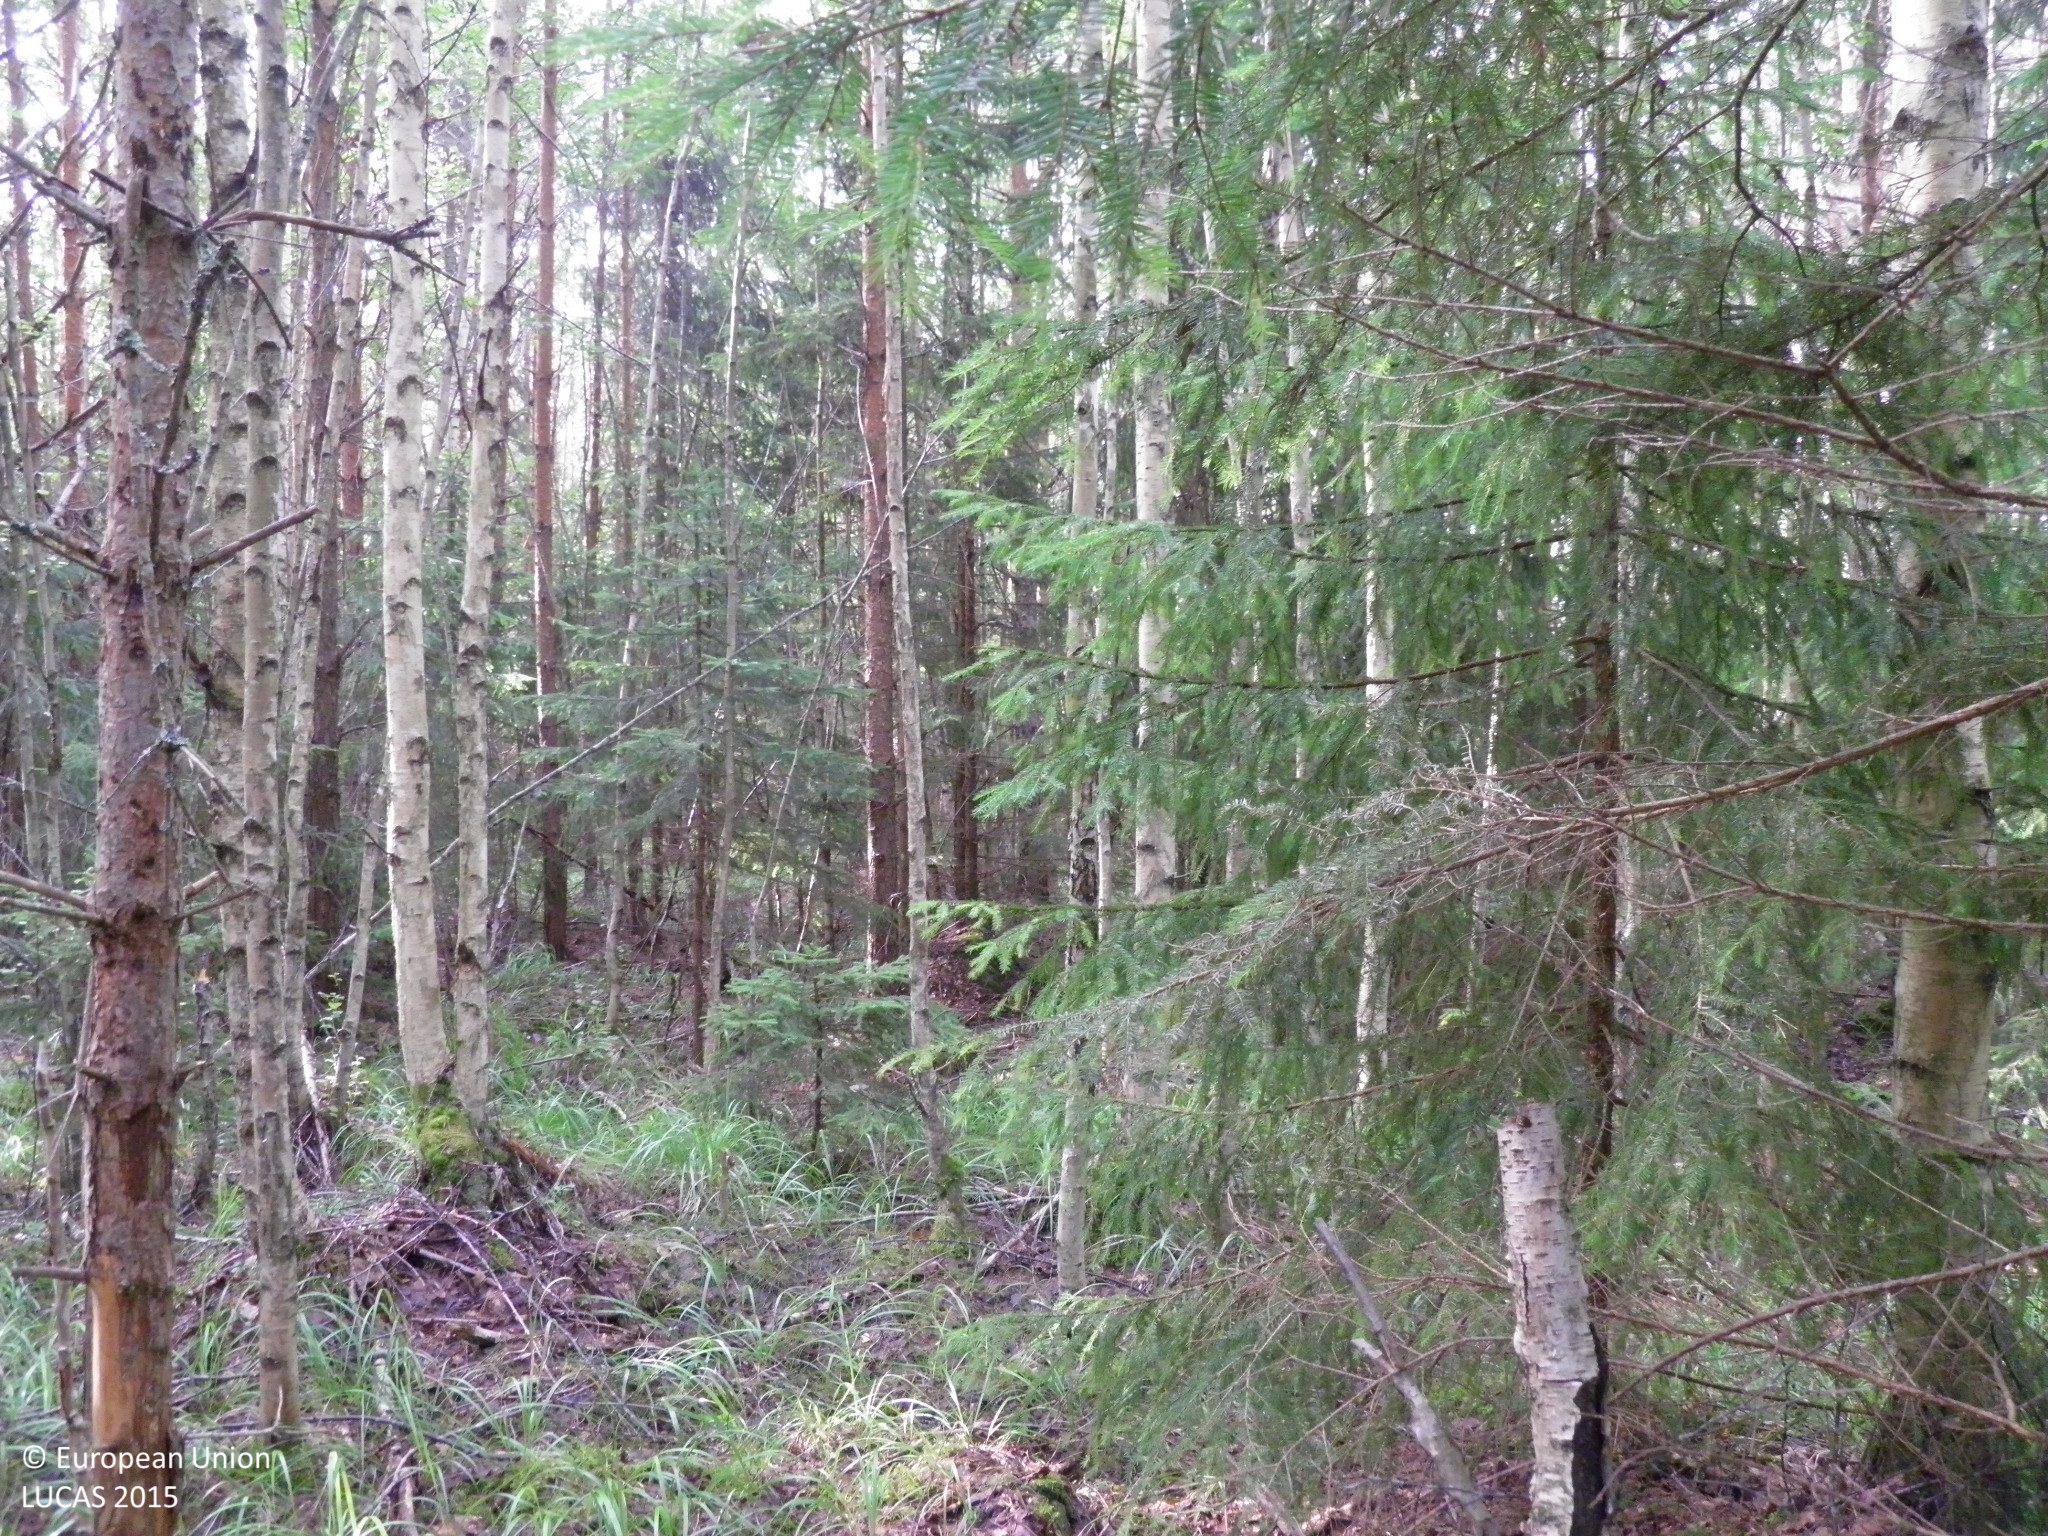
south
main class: Woodland
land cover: Pine dominated mixed woodland
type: hemiboreal forest and nemoral coniferous forest and mixed broadleaved-coniferous forest
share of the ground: > 75 %
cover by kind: broadleaved forest trees 50 %, coniferous forest trees 40 %, herbaceous plants 5 %, unconsolidated bare surface 5 %
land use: Semi-natural and natural areas not in use
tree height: > 5 m
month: July
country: FI
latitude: 60.7229
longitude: 22.4416
